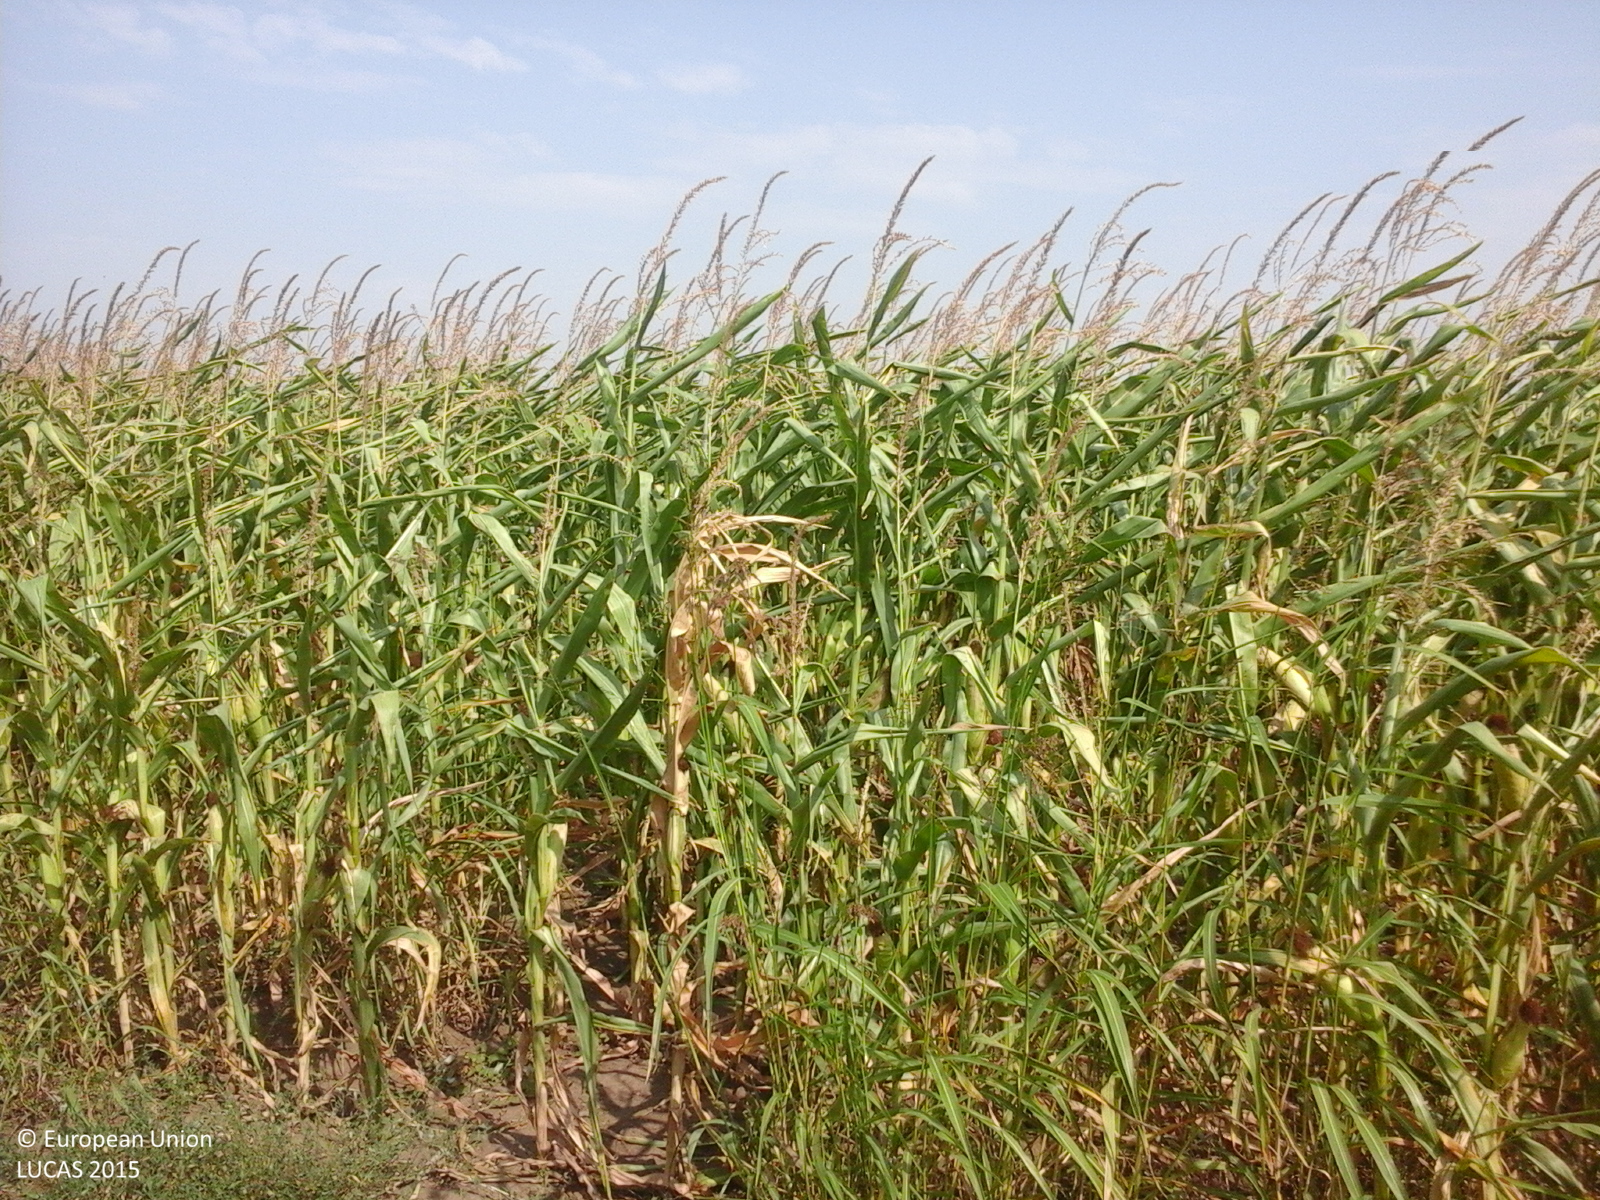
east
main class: Cropland
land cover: Maize
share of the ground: > 75 %
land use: Agriculture (excluding fallow land and kitchen gardens)
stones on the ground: < 10 %
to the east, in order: Maize
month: August
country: RO
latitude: 45.2147
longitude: 27.4541
